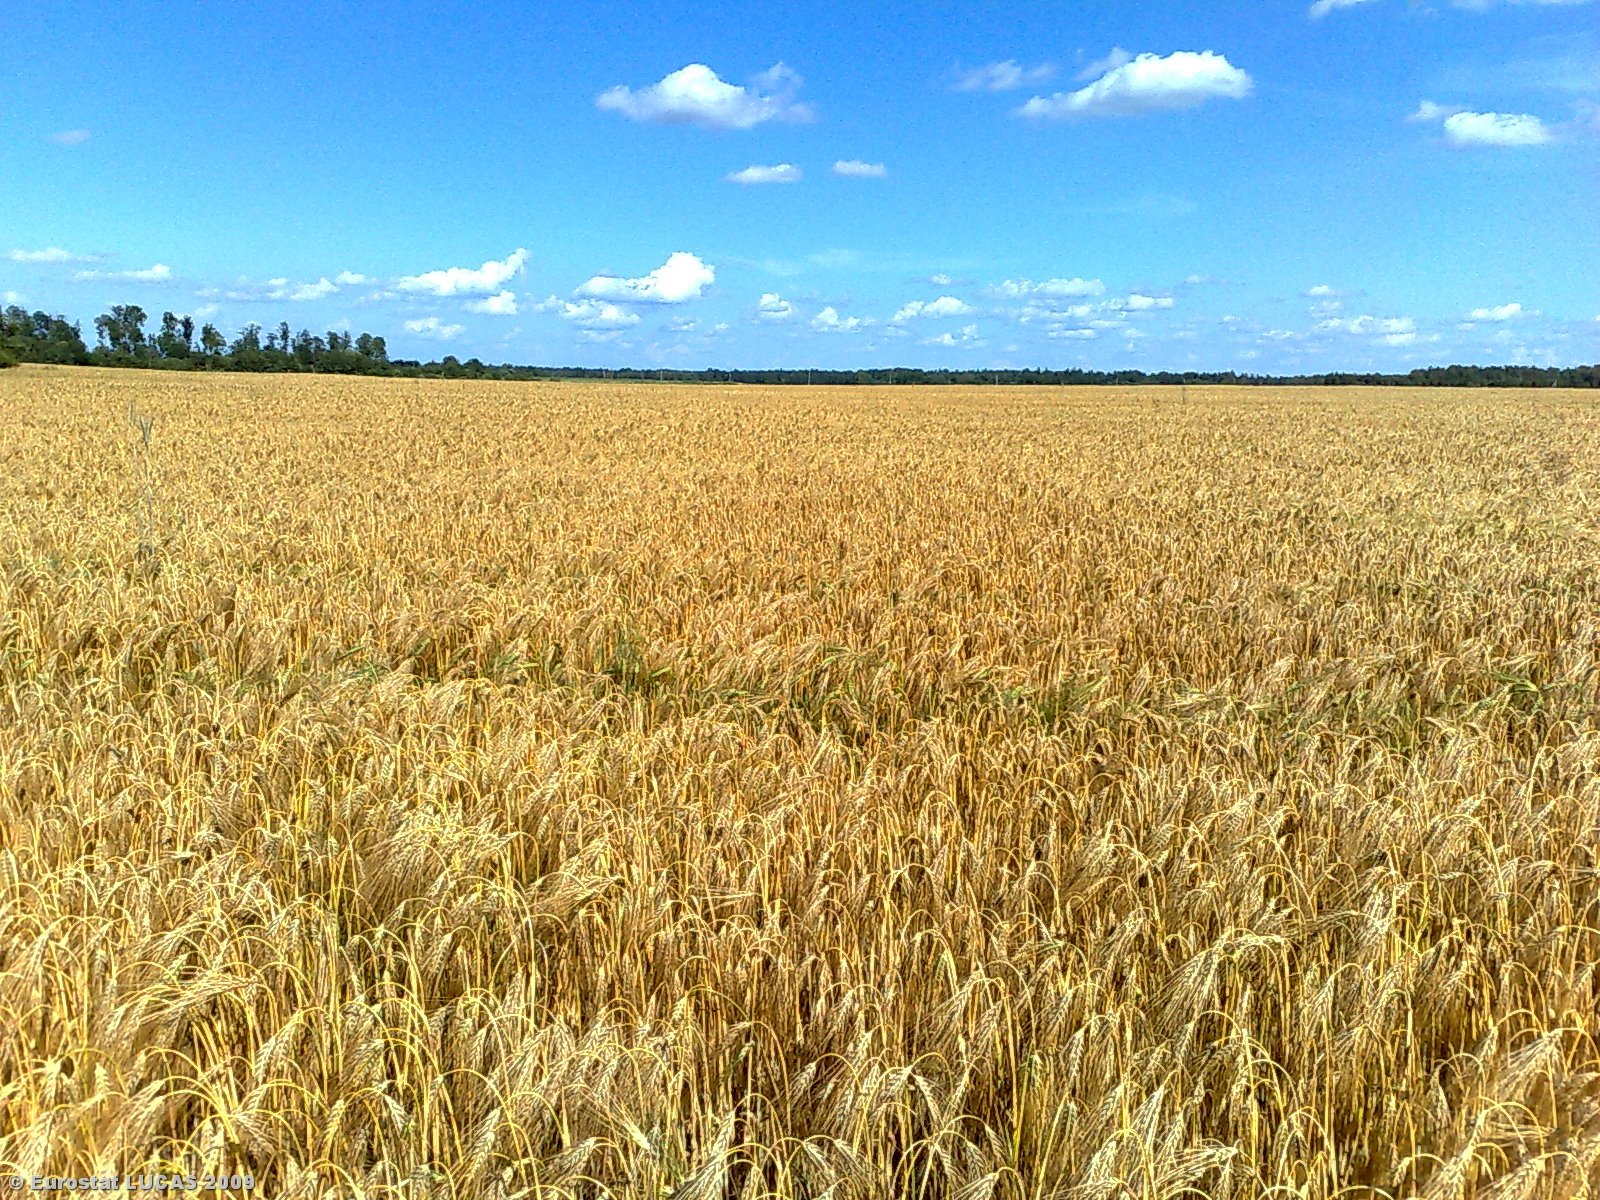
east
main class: Cropland
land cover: Triticale
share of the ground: > 75 %
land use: Agriculture (excluding fallow land and kitchen gardens)
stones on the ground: < 10 %
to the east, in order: Triticale
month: July
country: LT
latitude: 56.0942
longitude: 22.9416
